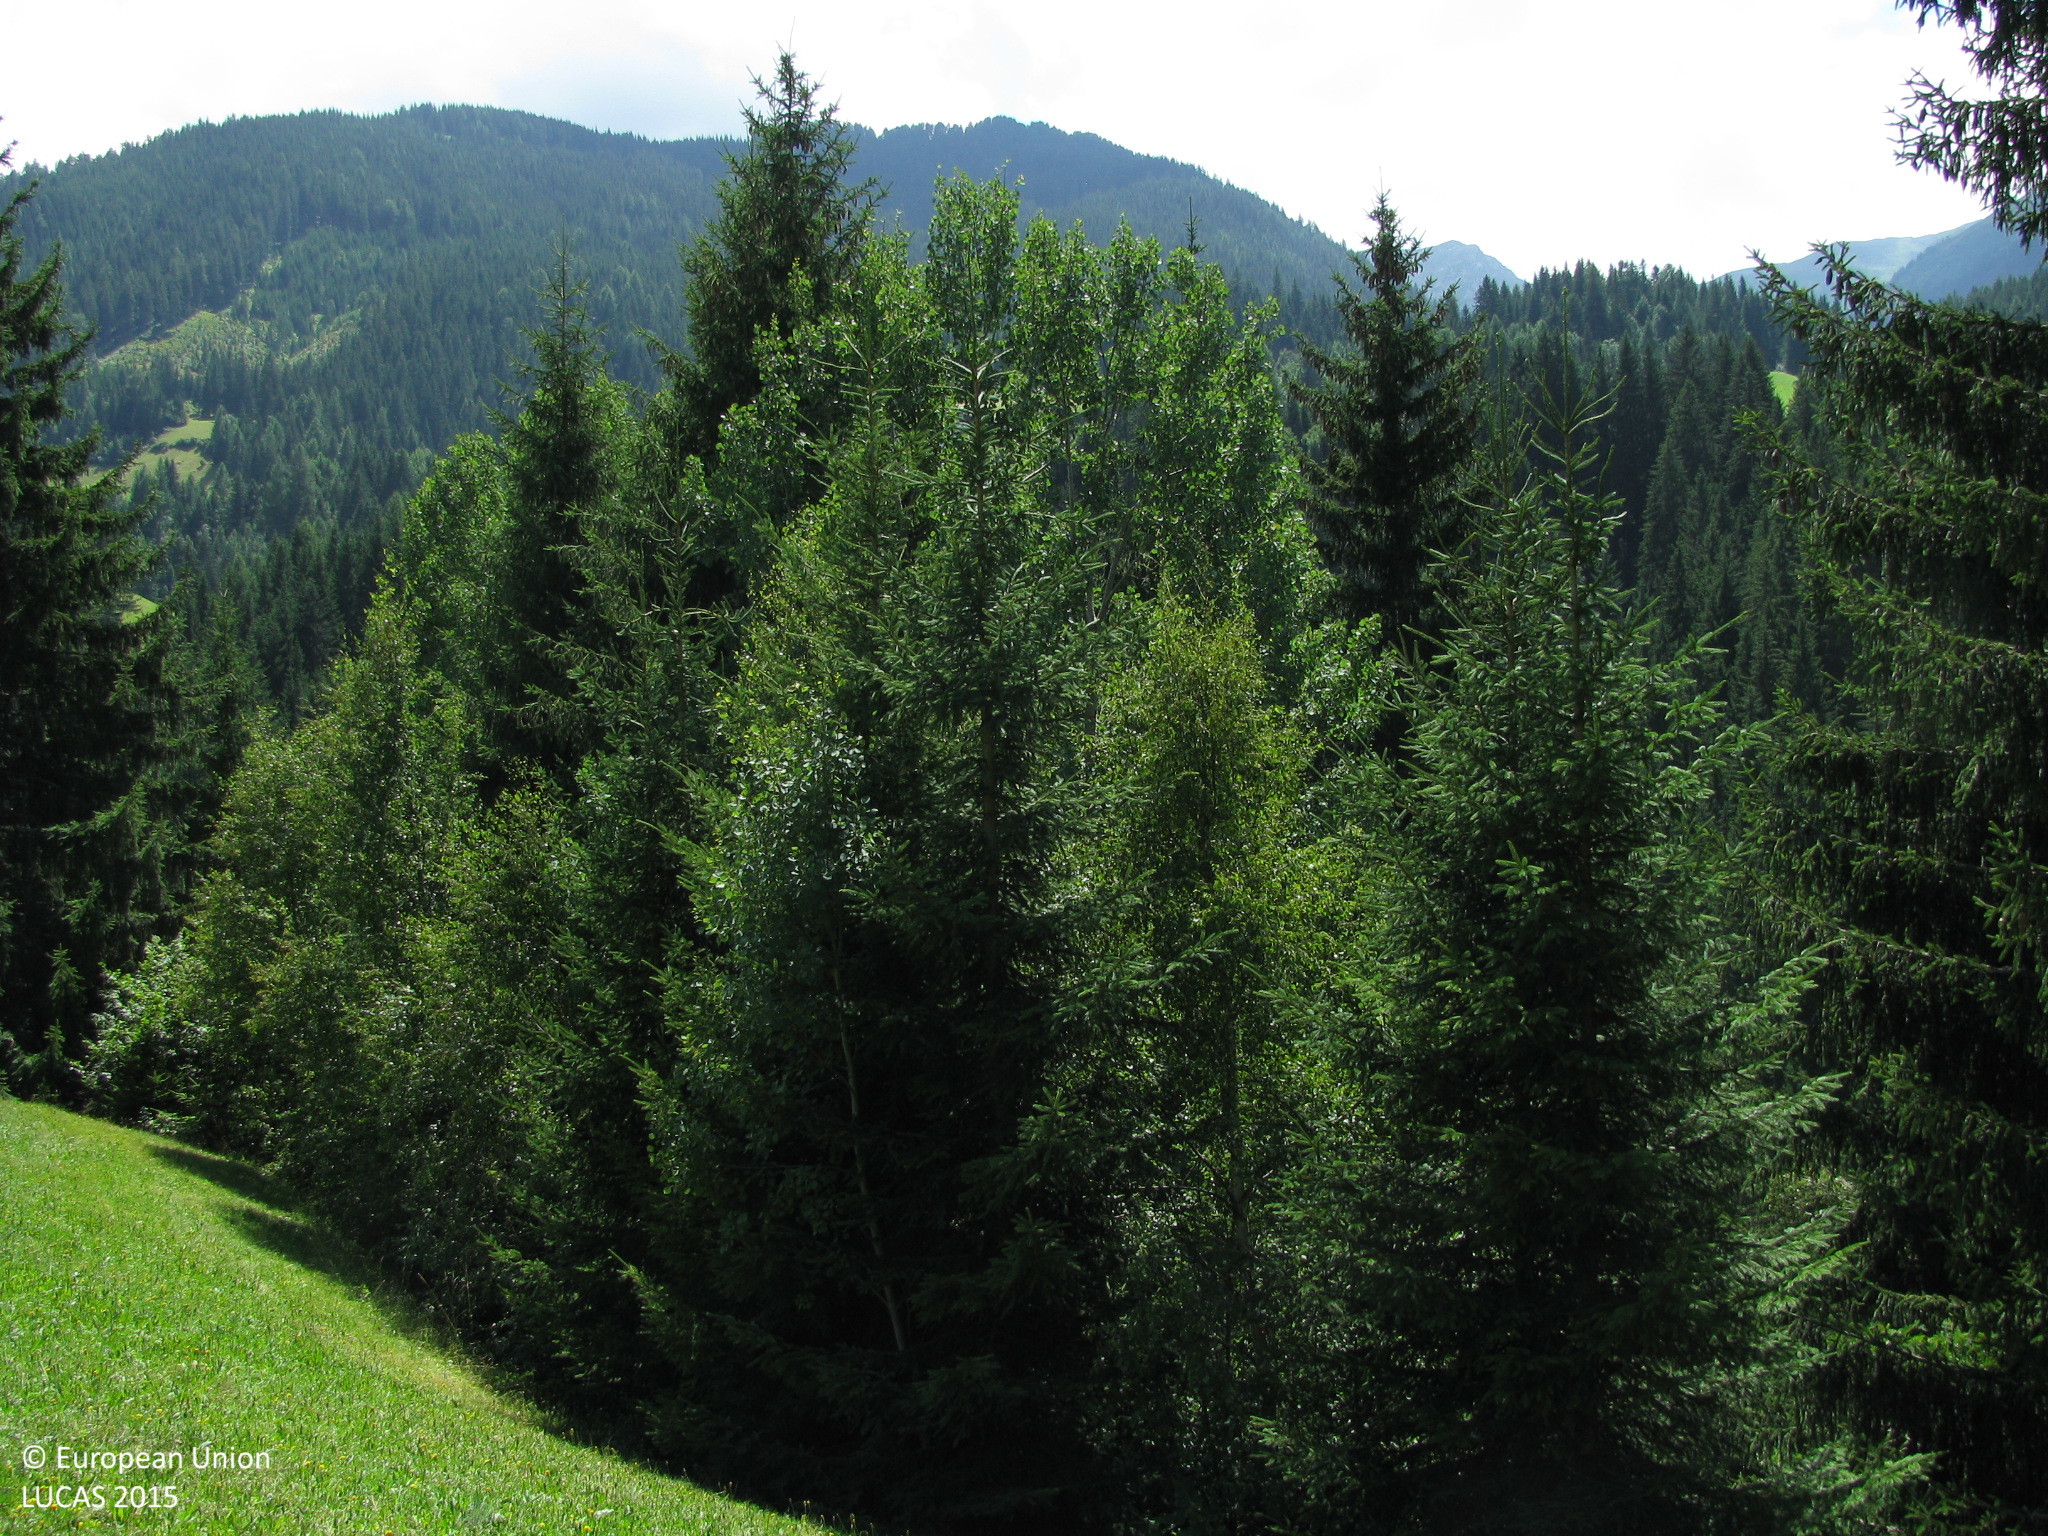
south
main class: Grassland
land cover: Grassland without tree/shrub cover
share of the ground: > 75 %
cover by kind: herbaceous plants 100 %
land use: Agriculture (excluding fallow land and kitchen gardens)
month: July
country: AT
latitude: 46.7371
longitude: 12.4711
